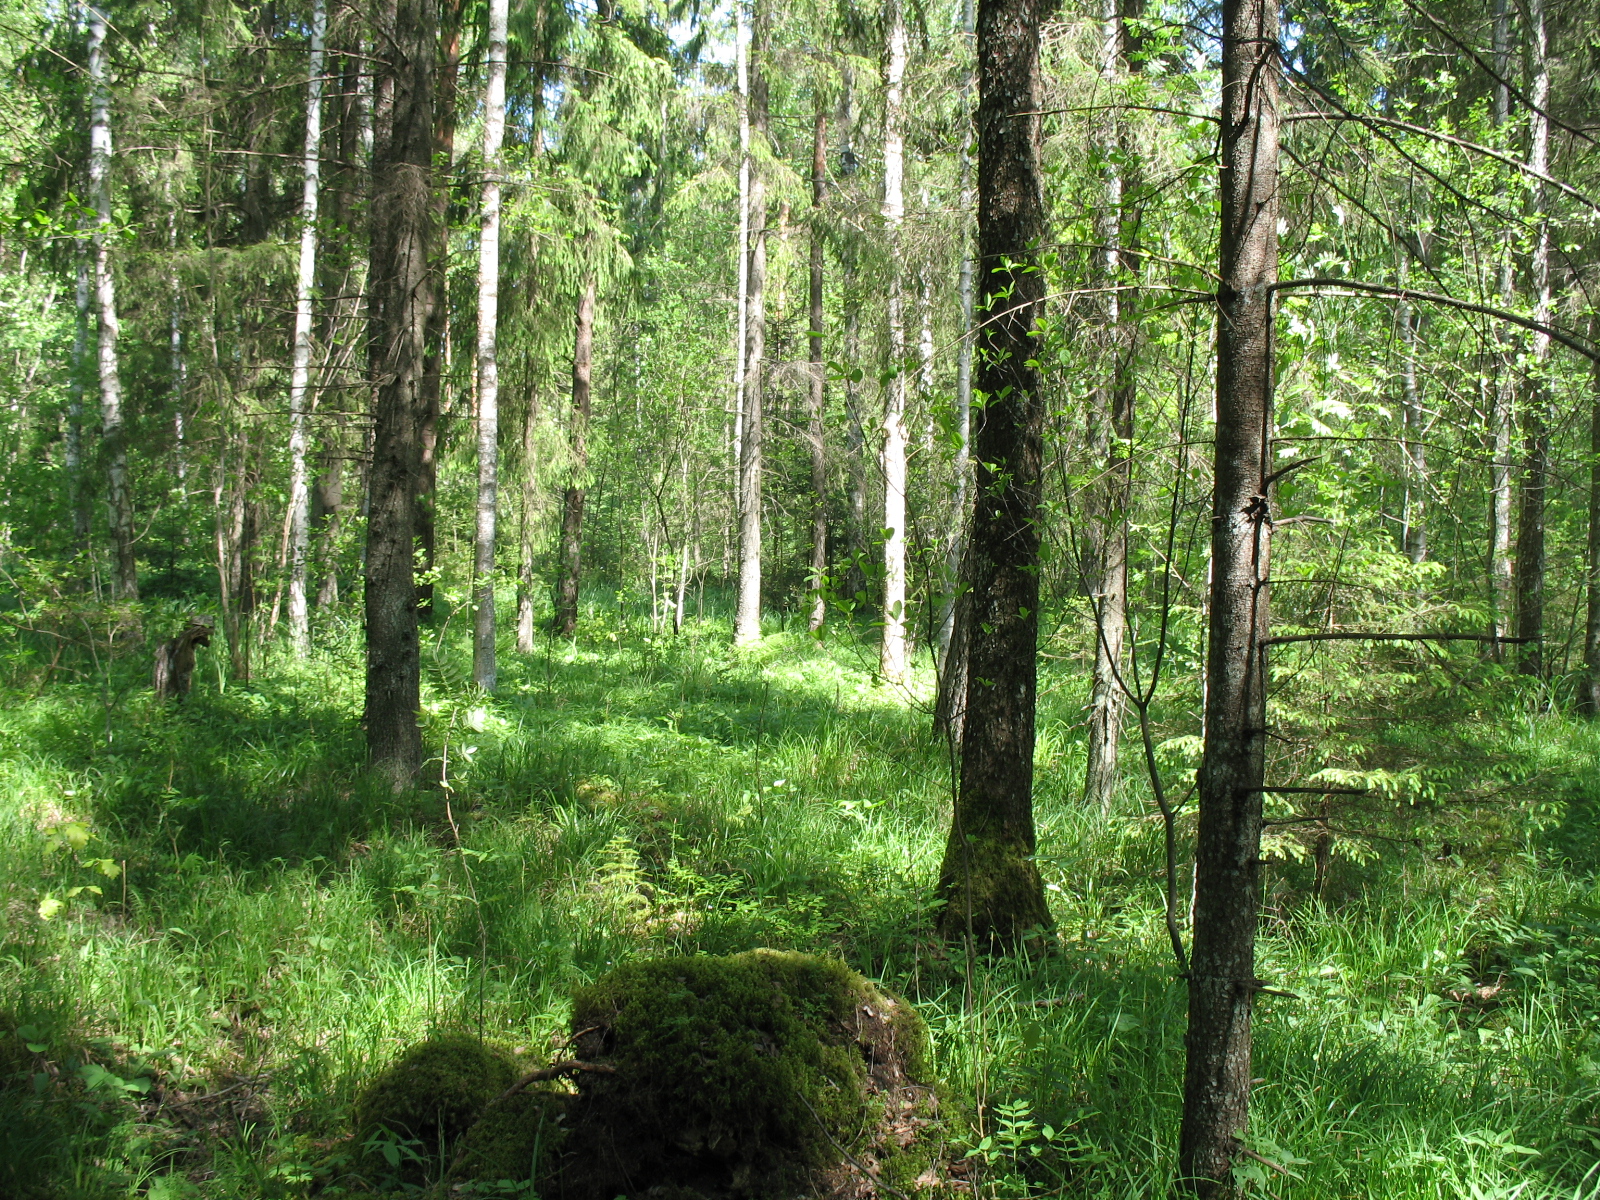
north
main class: Woodland
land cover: Spruce dominated mixed woodland
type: mire and swamp forests
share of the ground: > 75 %
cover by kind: broadleaved forest trees 50 %, coniferous forest trees 45 %, herbaceous plants 5 %
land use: Forestry
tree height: > 5 m
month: May
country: LV
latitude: 56.8541
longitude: 23.5374
